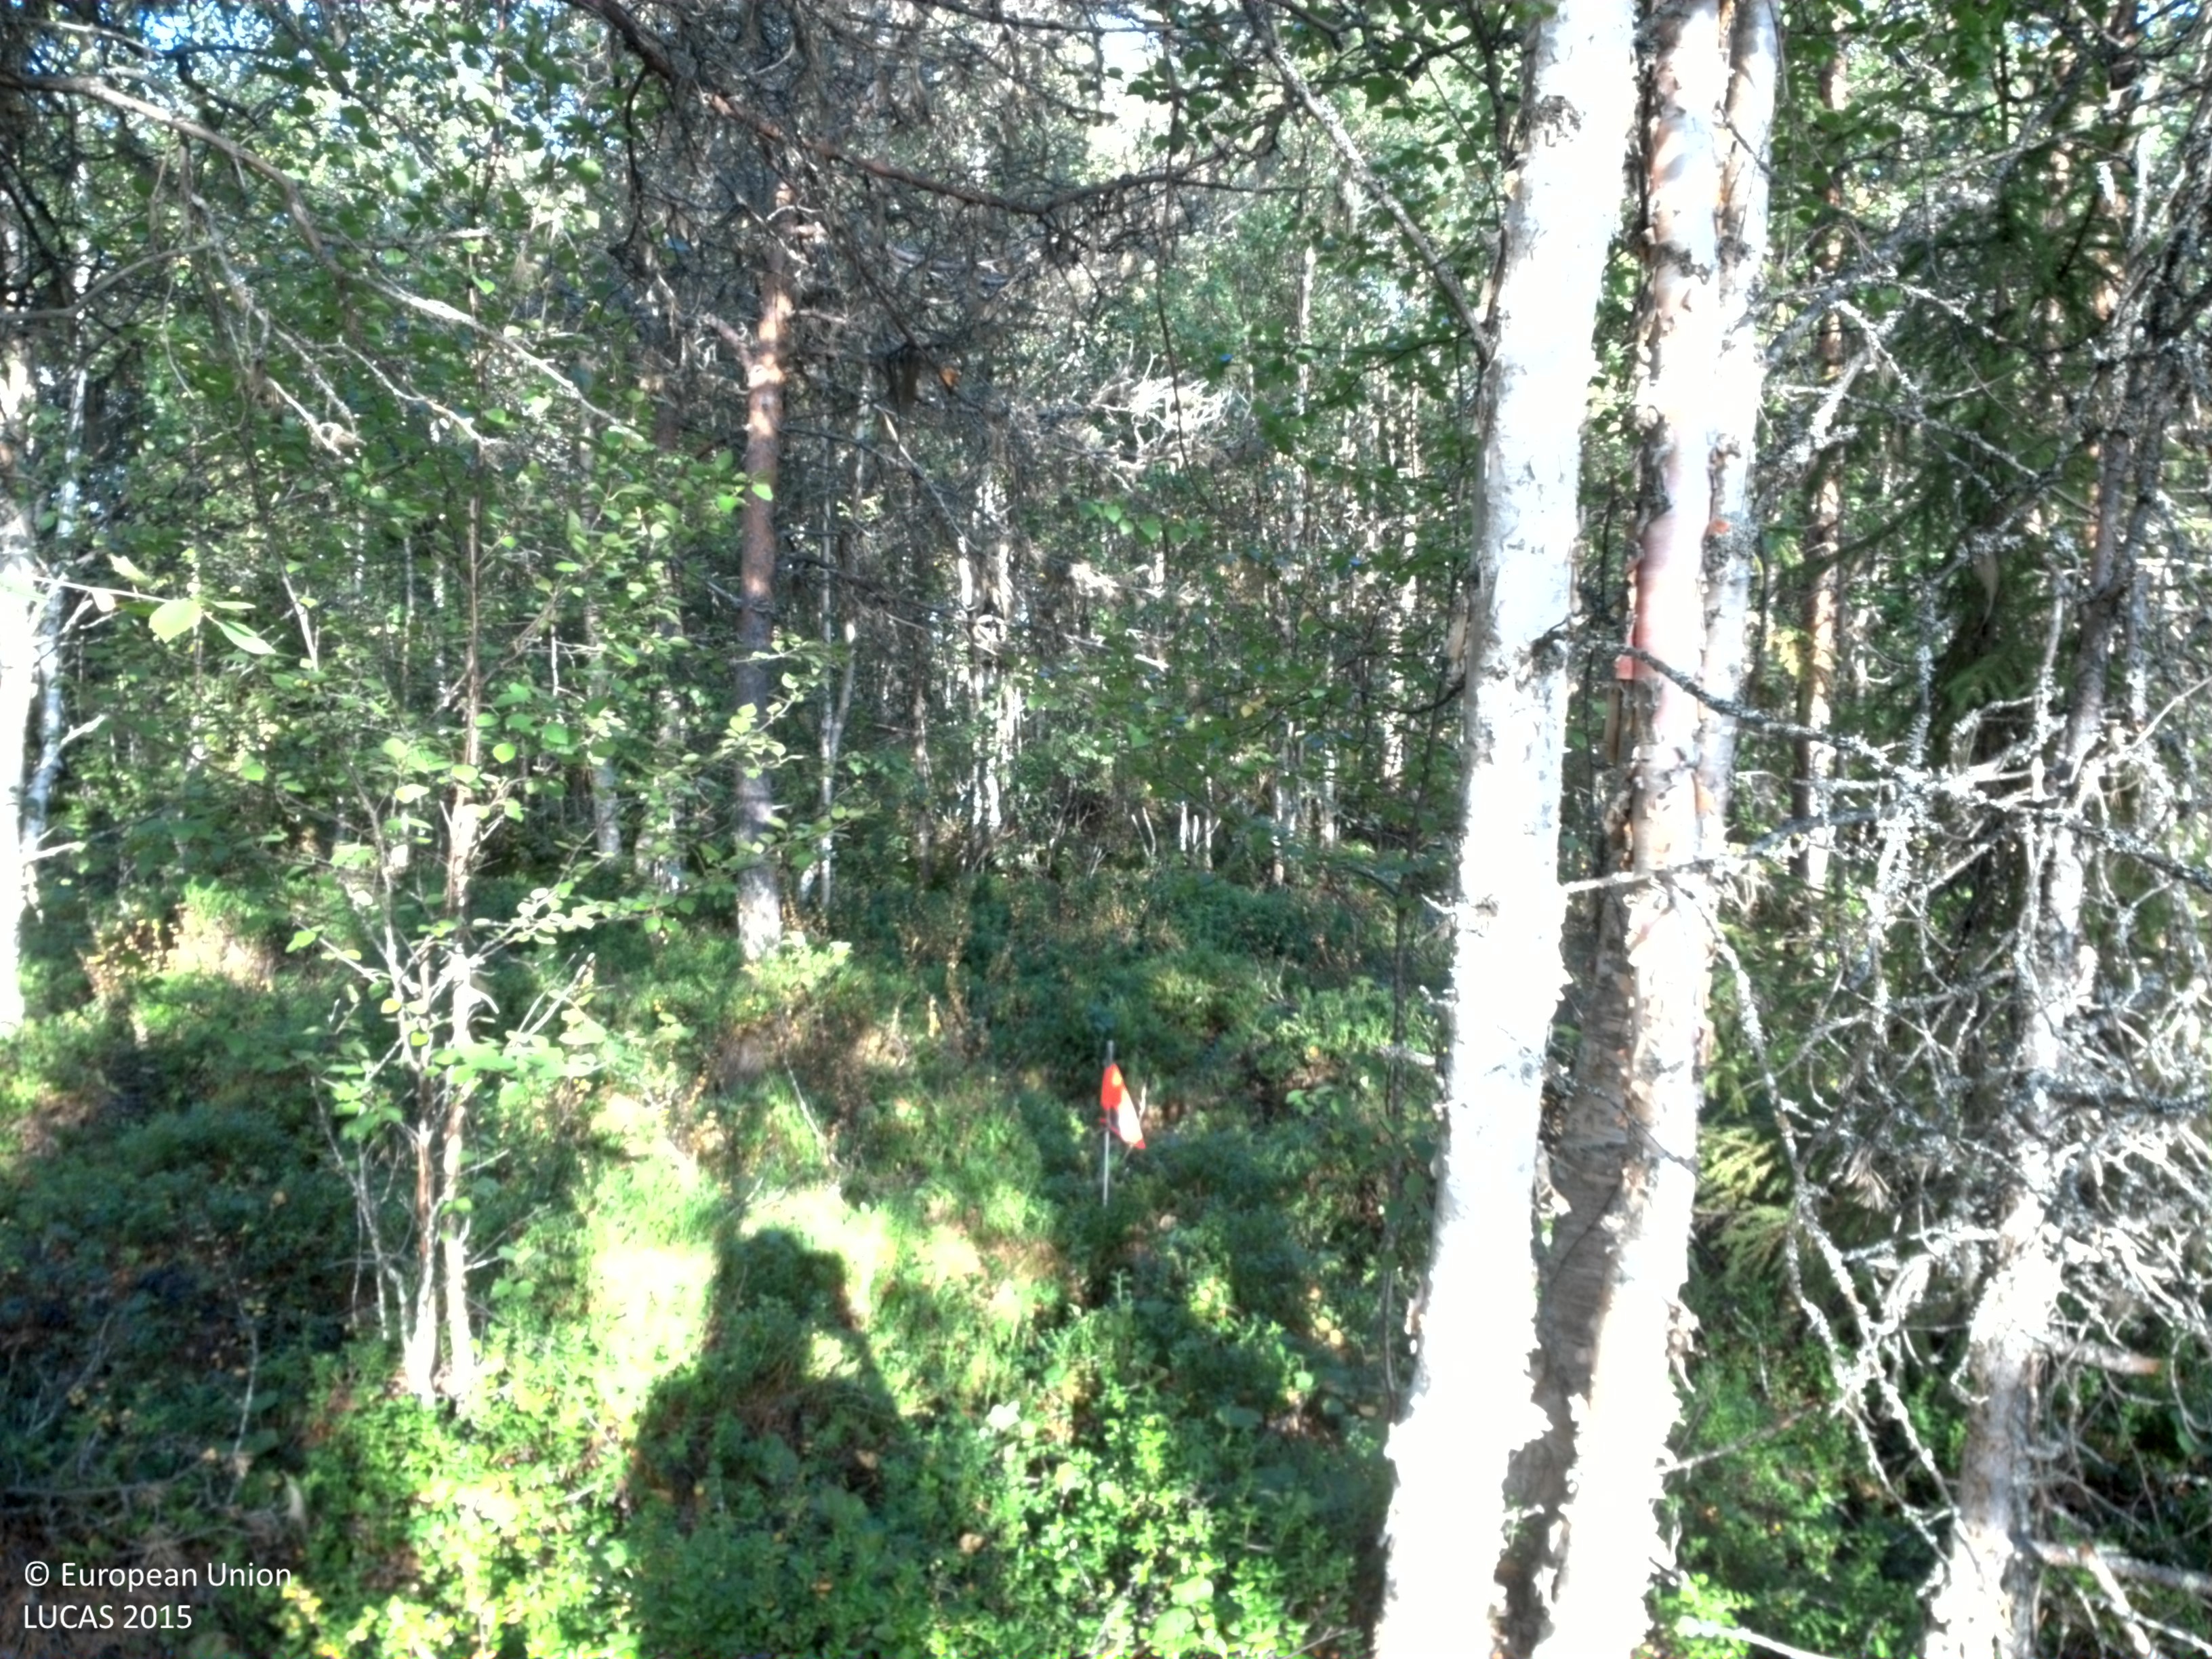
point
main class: Woodland
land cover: Pine dominated mixed woodland
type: boreal forest
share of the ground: 25 - 50 %
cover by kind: shrubs 45 %, coniferous forest trees 30 %, broadleaved forest trees 10 %, lichens and mosses 10 %, herbaceous plants 5 %
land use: Forestry
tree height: > 5 m
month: August
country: SE
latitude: 64.5773
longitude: 16.8356
